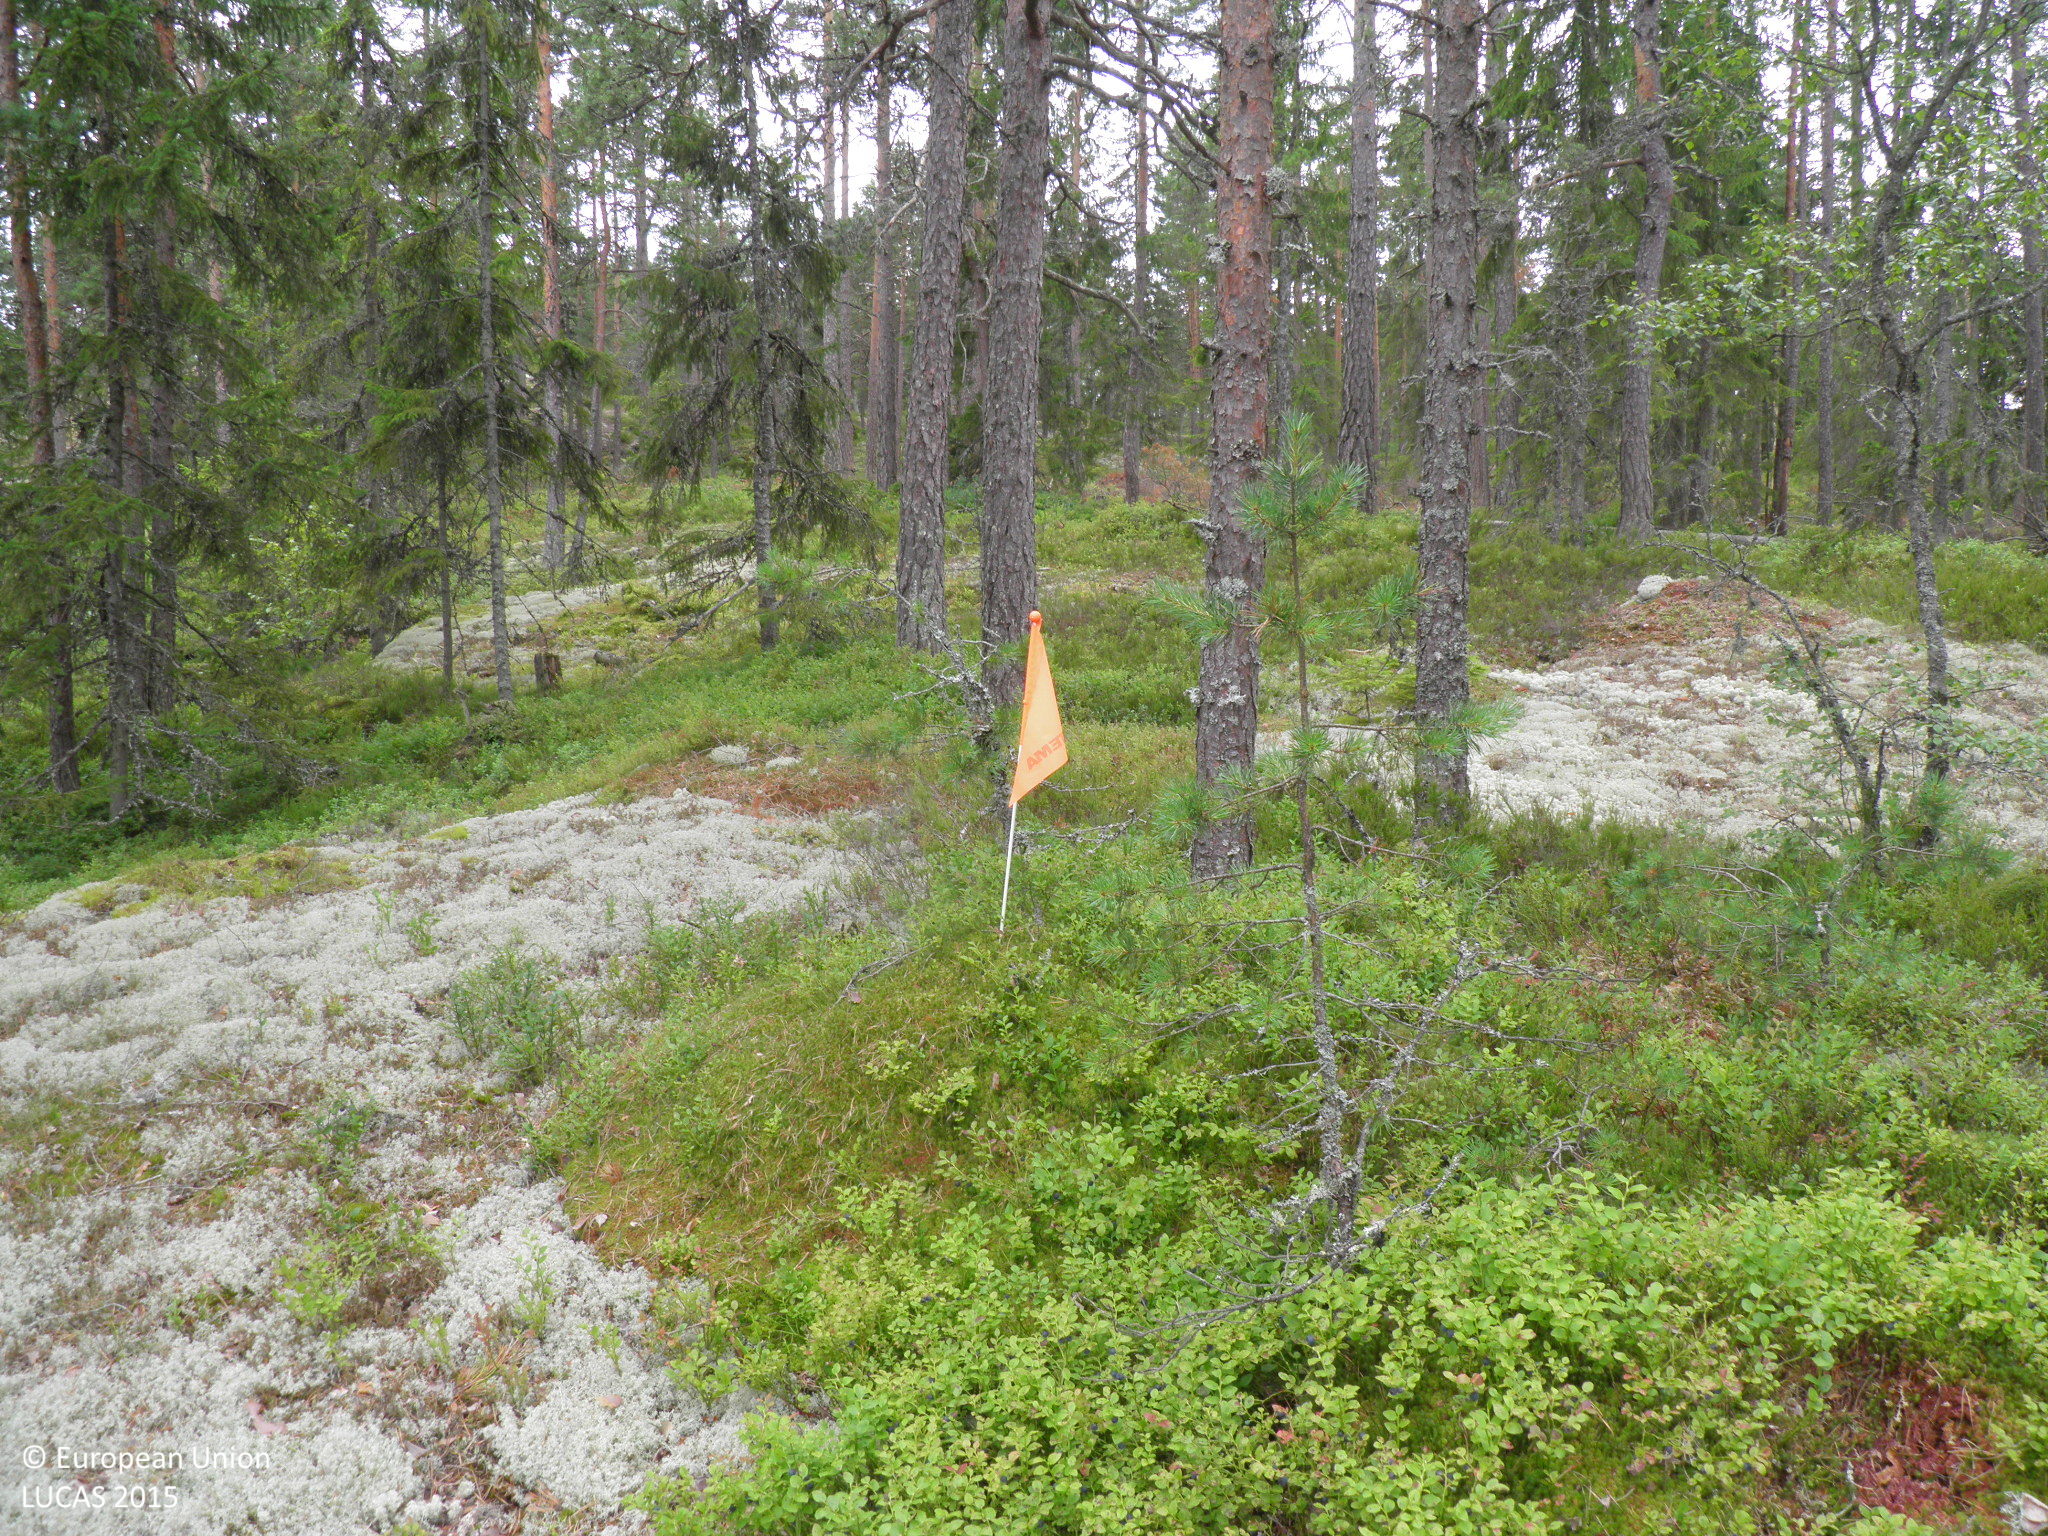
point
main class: Woodland
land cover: Pine dominated coniferous woodland
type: hemiboreal forest and nemoral coniferous forest and mixed broadleaved-coniferous forest
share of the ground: 25 - 50 %
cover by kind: coniferous forest trees 40 %, shrubs 30 %, lichens and mosses 30 %
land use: Forestry
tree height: > 5 m
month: July
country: FI
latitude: 60.2286
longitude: 22.6586
